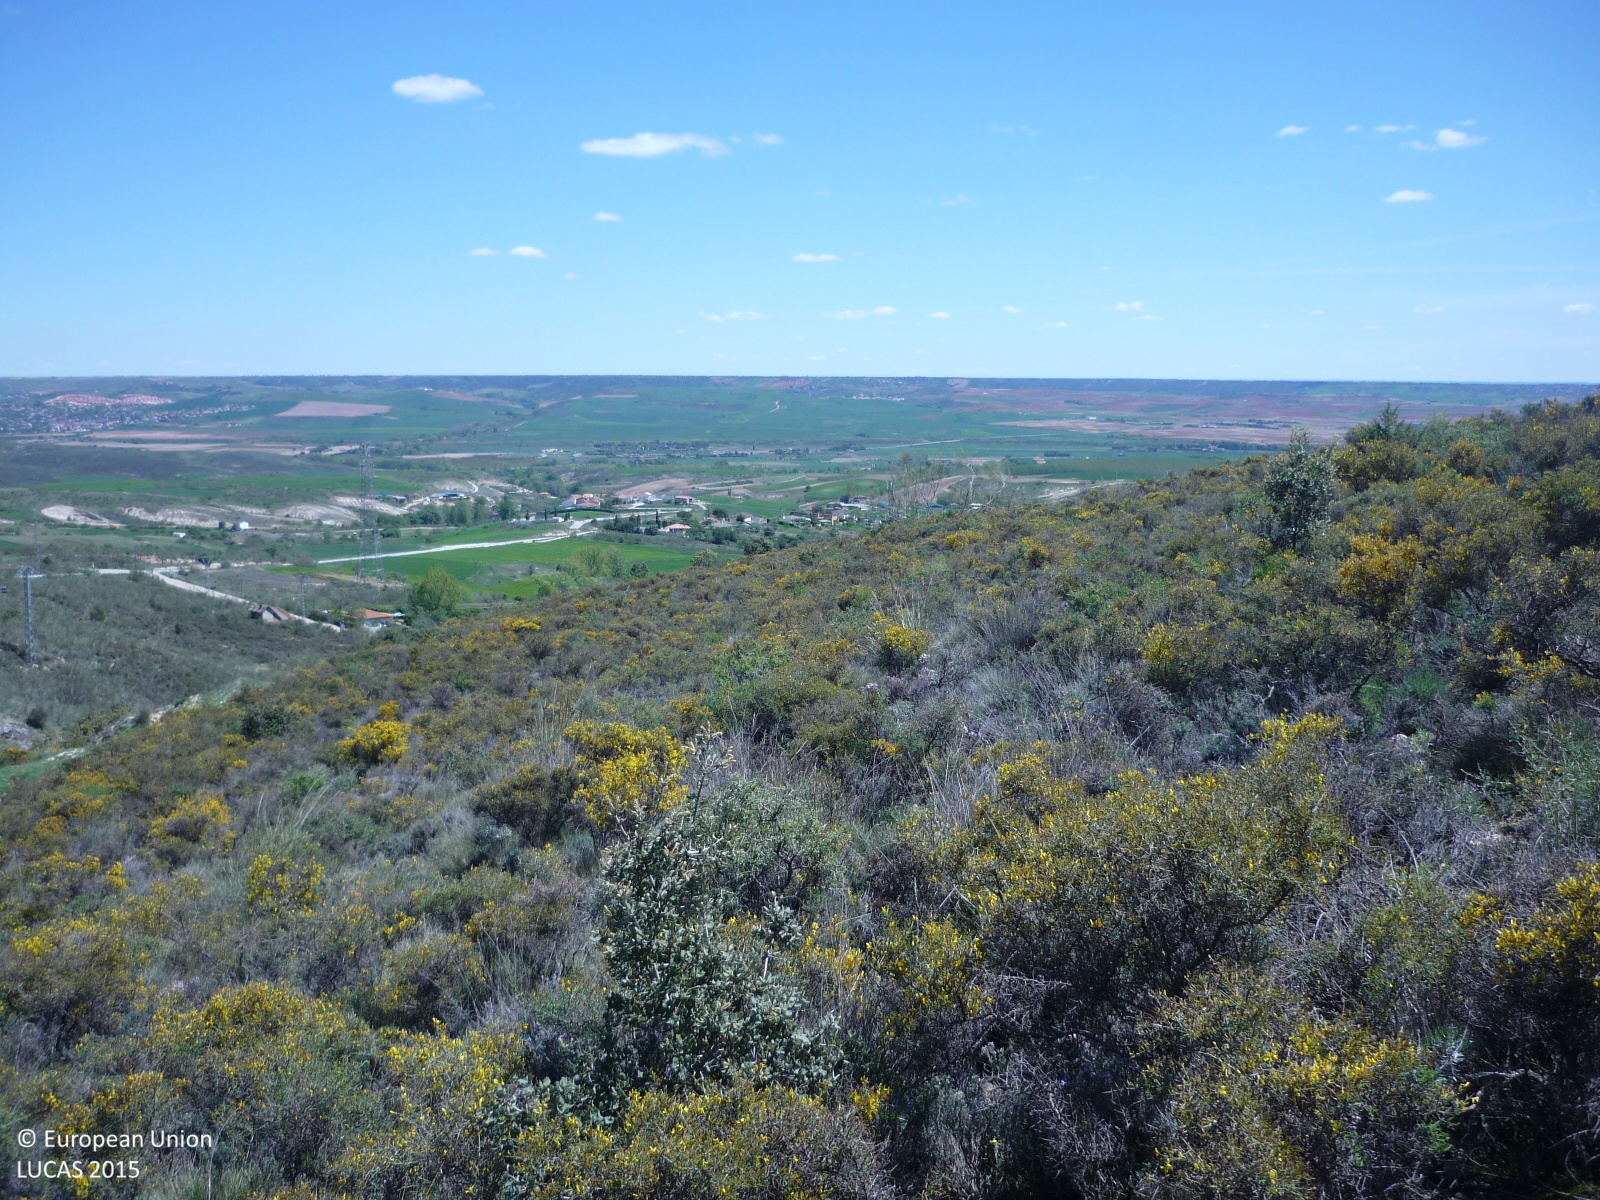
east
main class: Shrubland
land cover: Shrubland without tree cover
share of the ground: > 75 %
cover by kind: shrubs 75 %, herbaceous plants 25 %
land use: Semi-natural and natural areas not in use
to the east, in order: Shrubland without tree cover; Electric lines; Dry stone walls; Tracks; Shrubland without tree cover
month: April
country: ES
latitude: 40.7681
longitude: -3.5575
